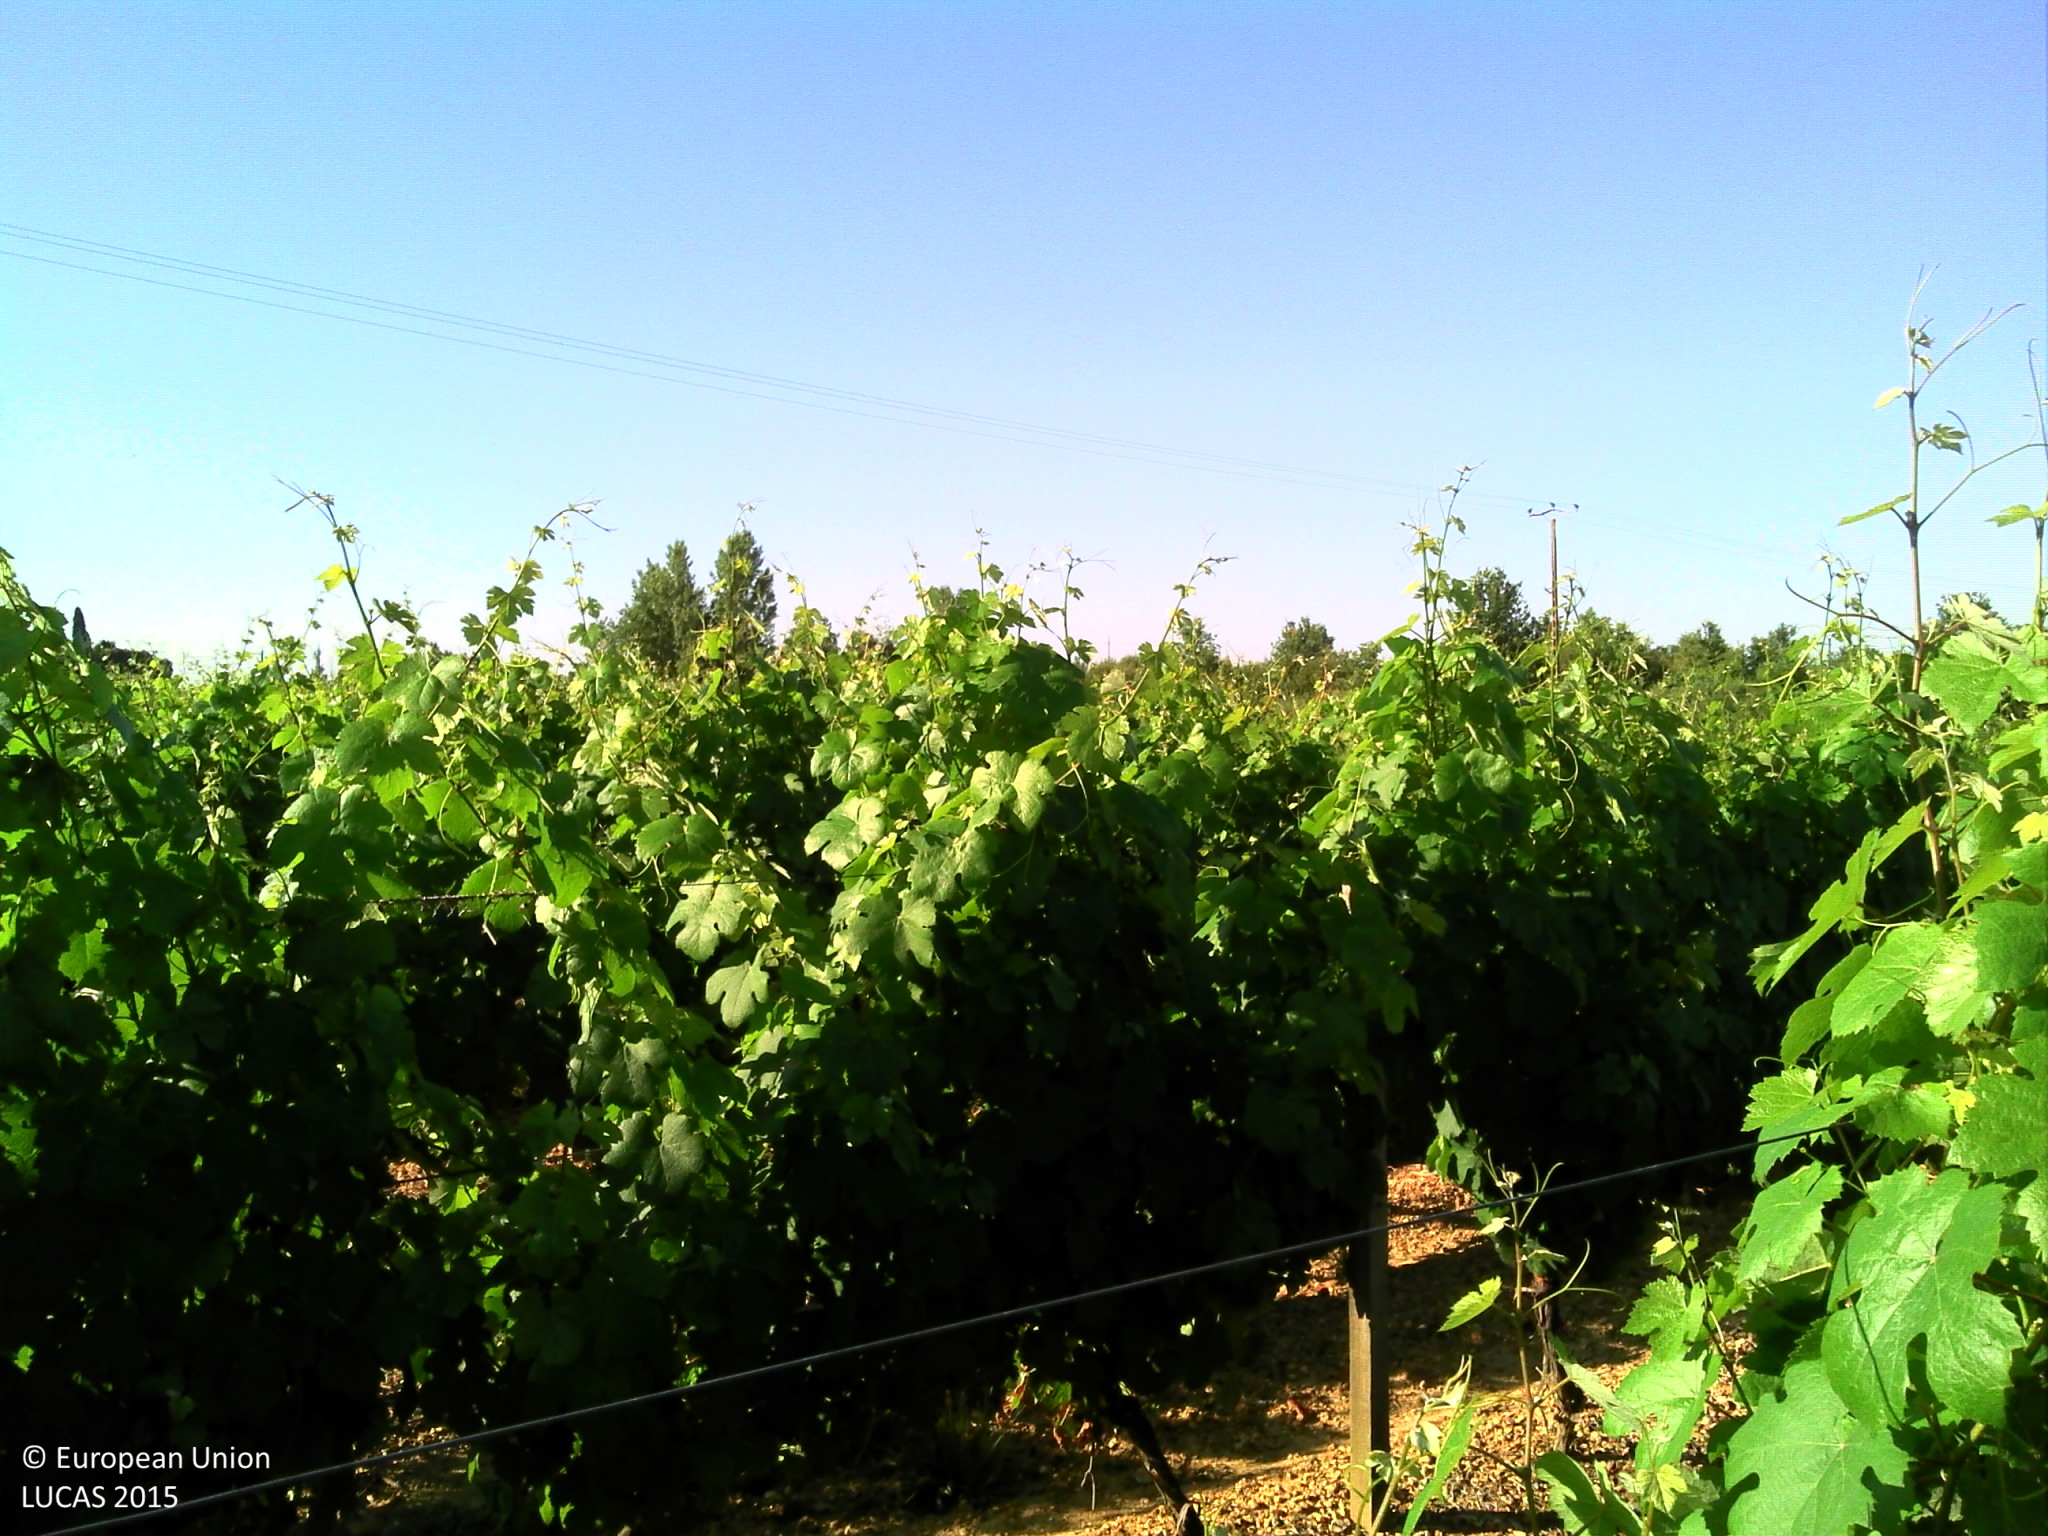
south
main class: Cropland
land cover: Vineyards
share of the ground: 25 - 50 %
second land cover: Grassland without tree/shrub cover
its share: 50 - 75 %
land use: Agriculture (excluding fallow land and kitchen gardens)
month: June
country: FR
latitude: 43.8443
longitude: 1.3562
